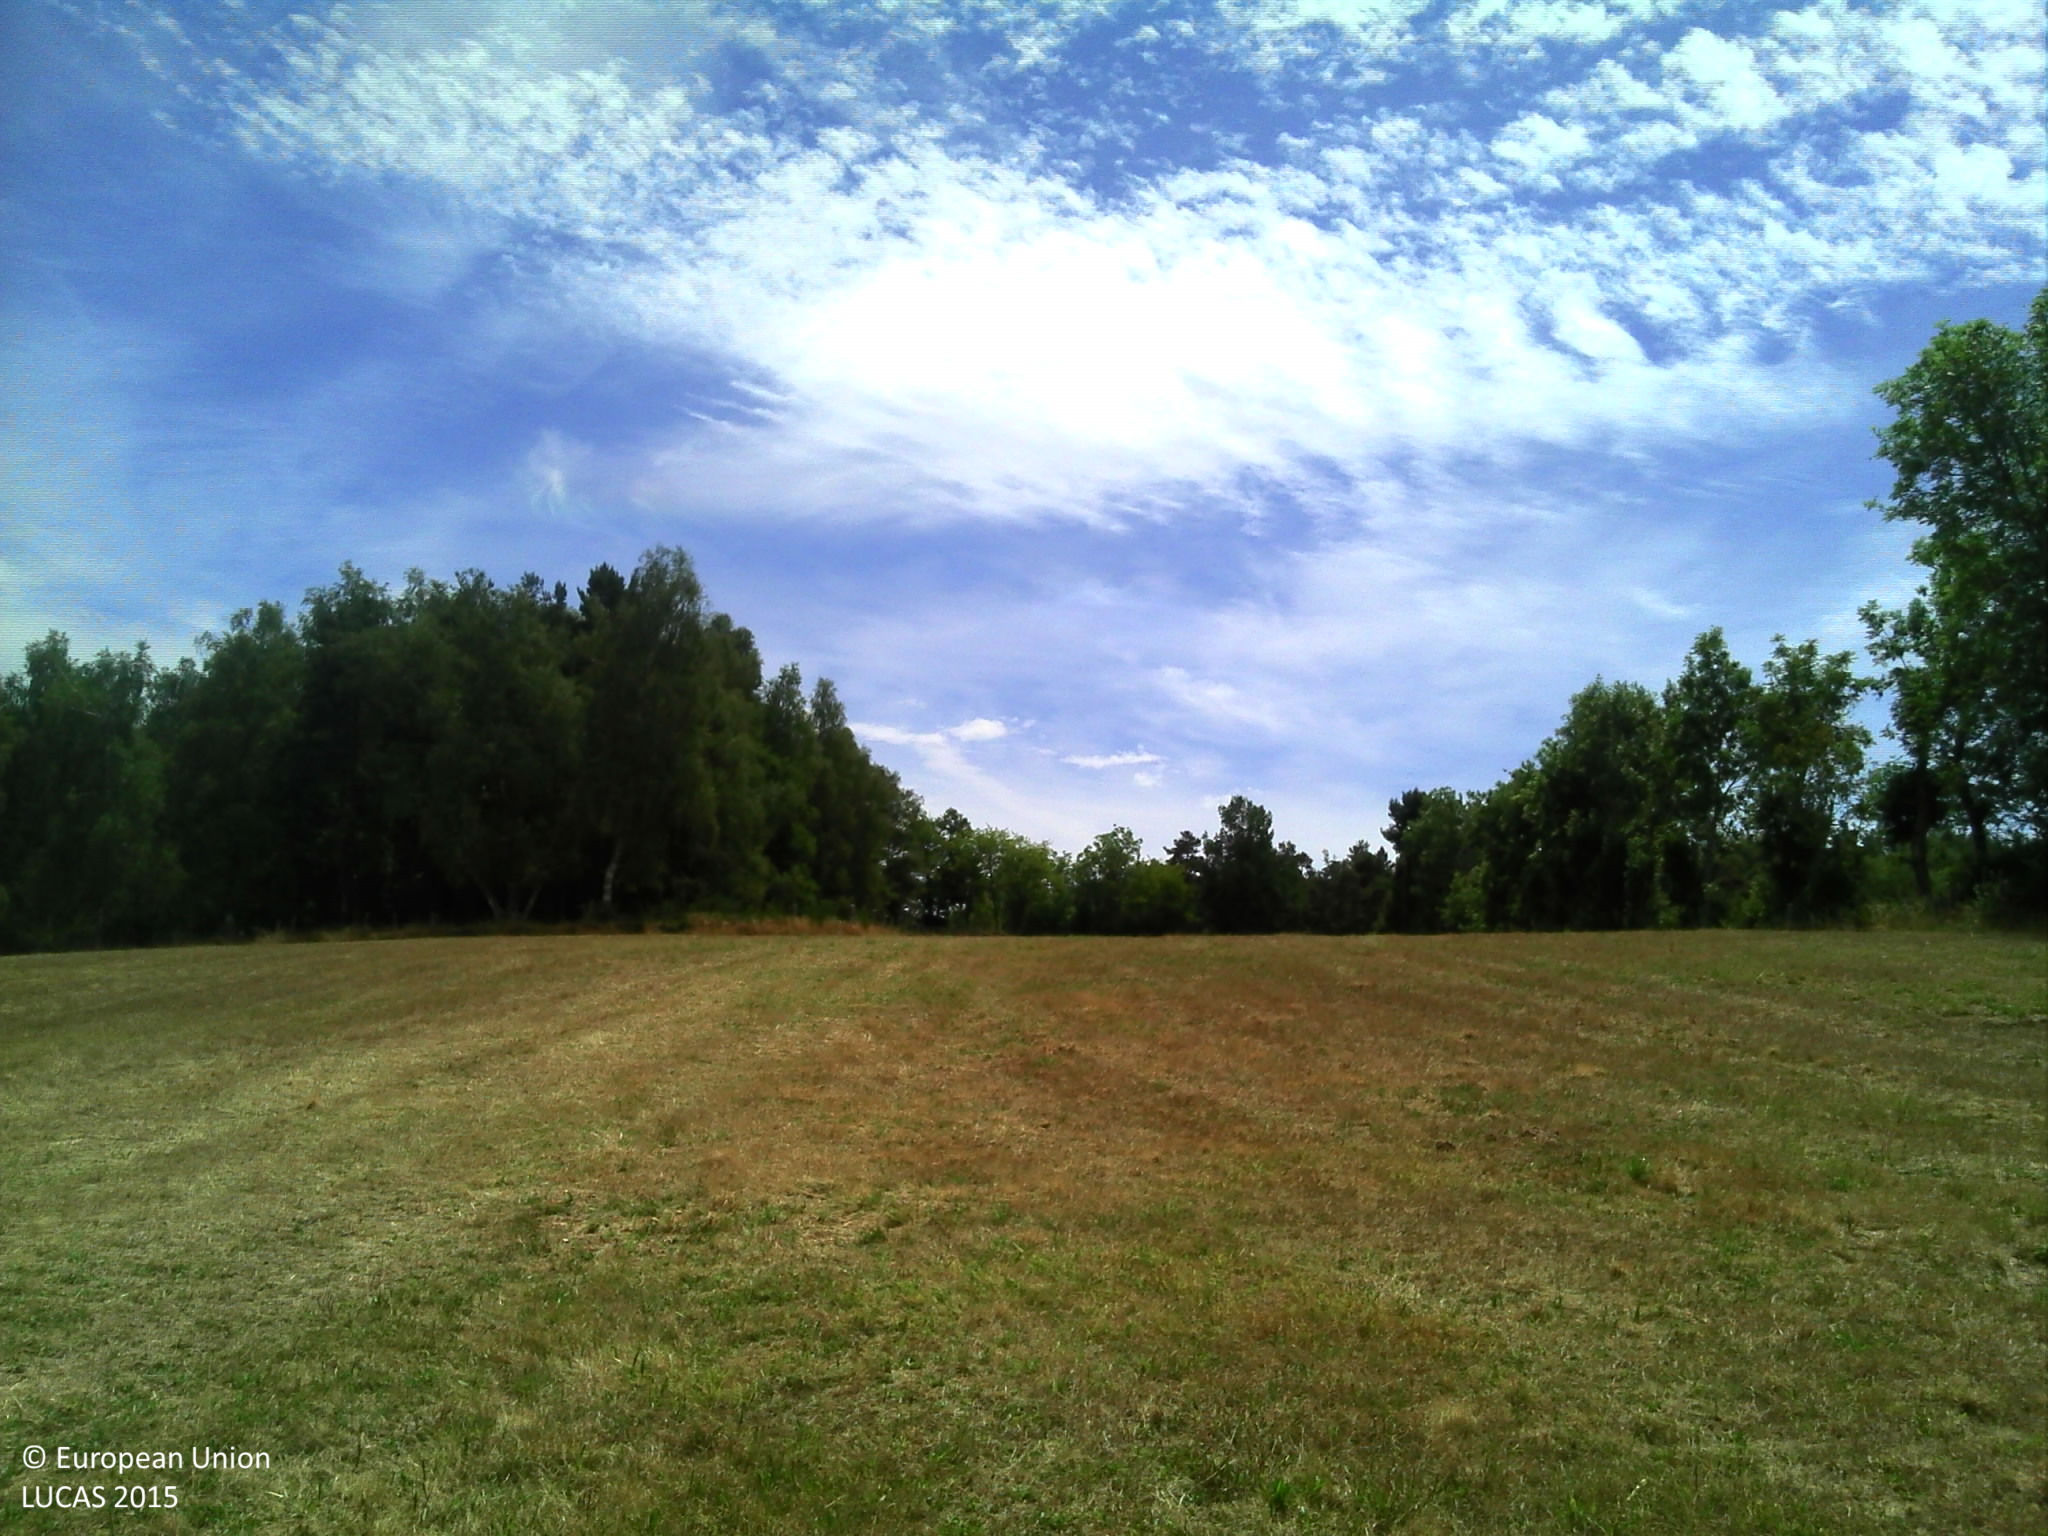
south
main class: Grassland
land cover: Grassland without tree/shrub cover
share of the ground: > 75 %
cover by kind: herbaceous plants 100 %
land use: Agriculture (excluding fallow land and kitchen gardens)
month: July
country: FR
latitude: 44.8712
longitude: 3.2315
